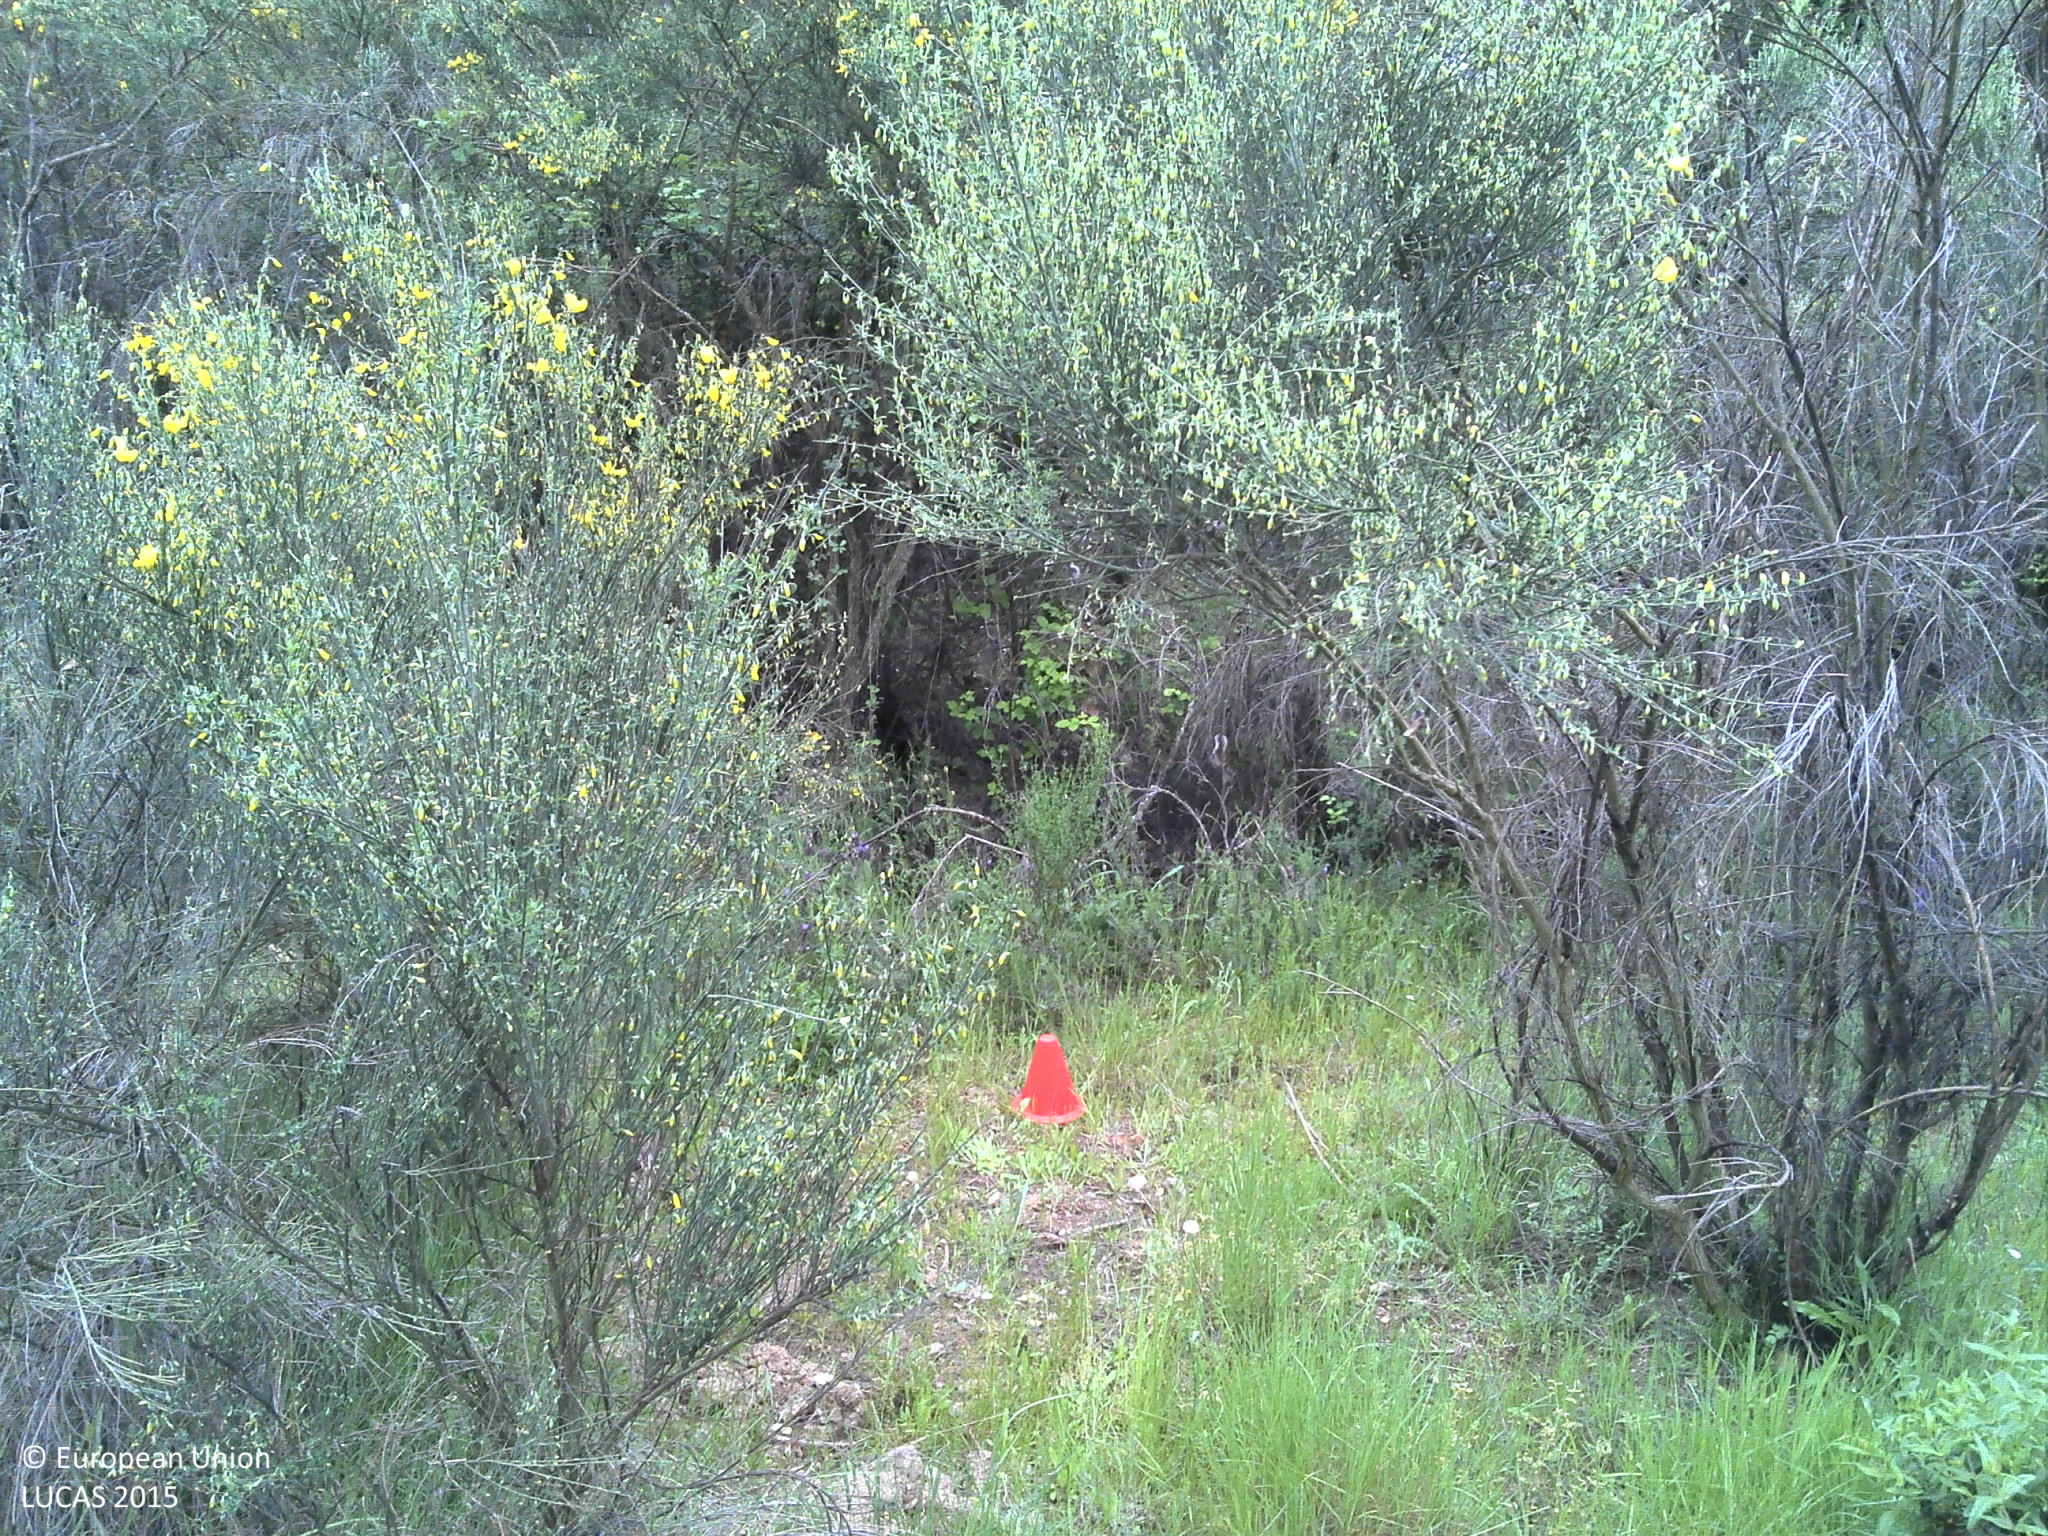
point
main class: Shrubland
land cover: Shrubland with sparse tree cover
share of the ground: > 75 %
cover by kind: shrubs 70 %, herbaceous plants 25 %, coniferous forest trees 5 %
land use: Semi-natural and natural areas not in use
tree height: > 5 m
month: May
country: PT
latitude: 41.7731
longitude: -7.1202
